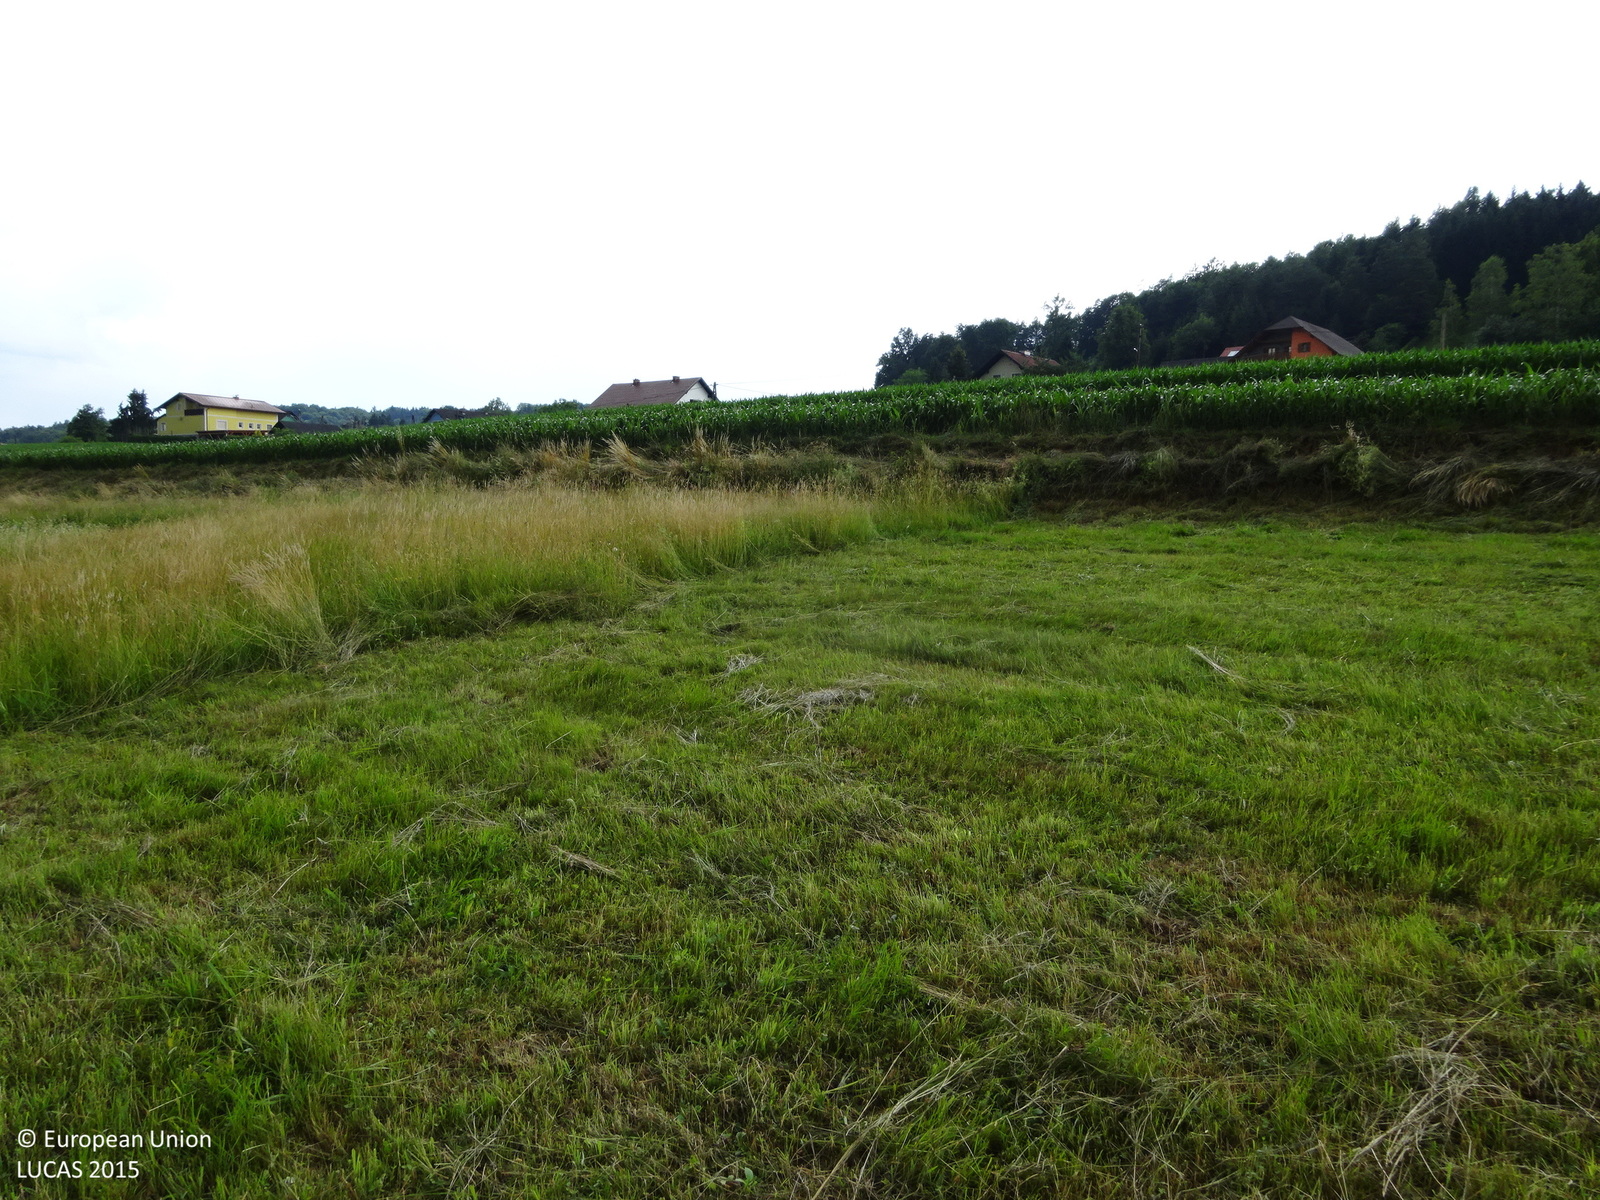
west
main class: Grassland
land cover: Grassland without tree/shrub cover
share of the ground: > 75 %
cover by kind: herbaceous plants 100 %
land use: Agriculture (excluding fallow land and kitchen gardens)
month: June
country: AT
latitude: 46.7201
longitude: 15.4023
